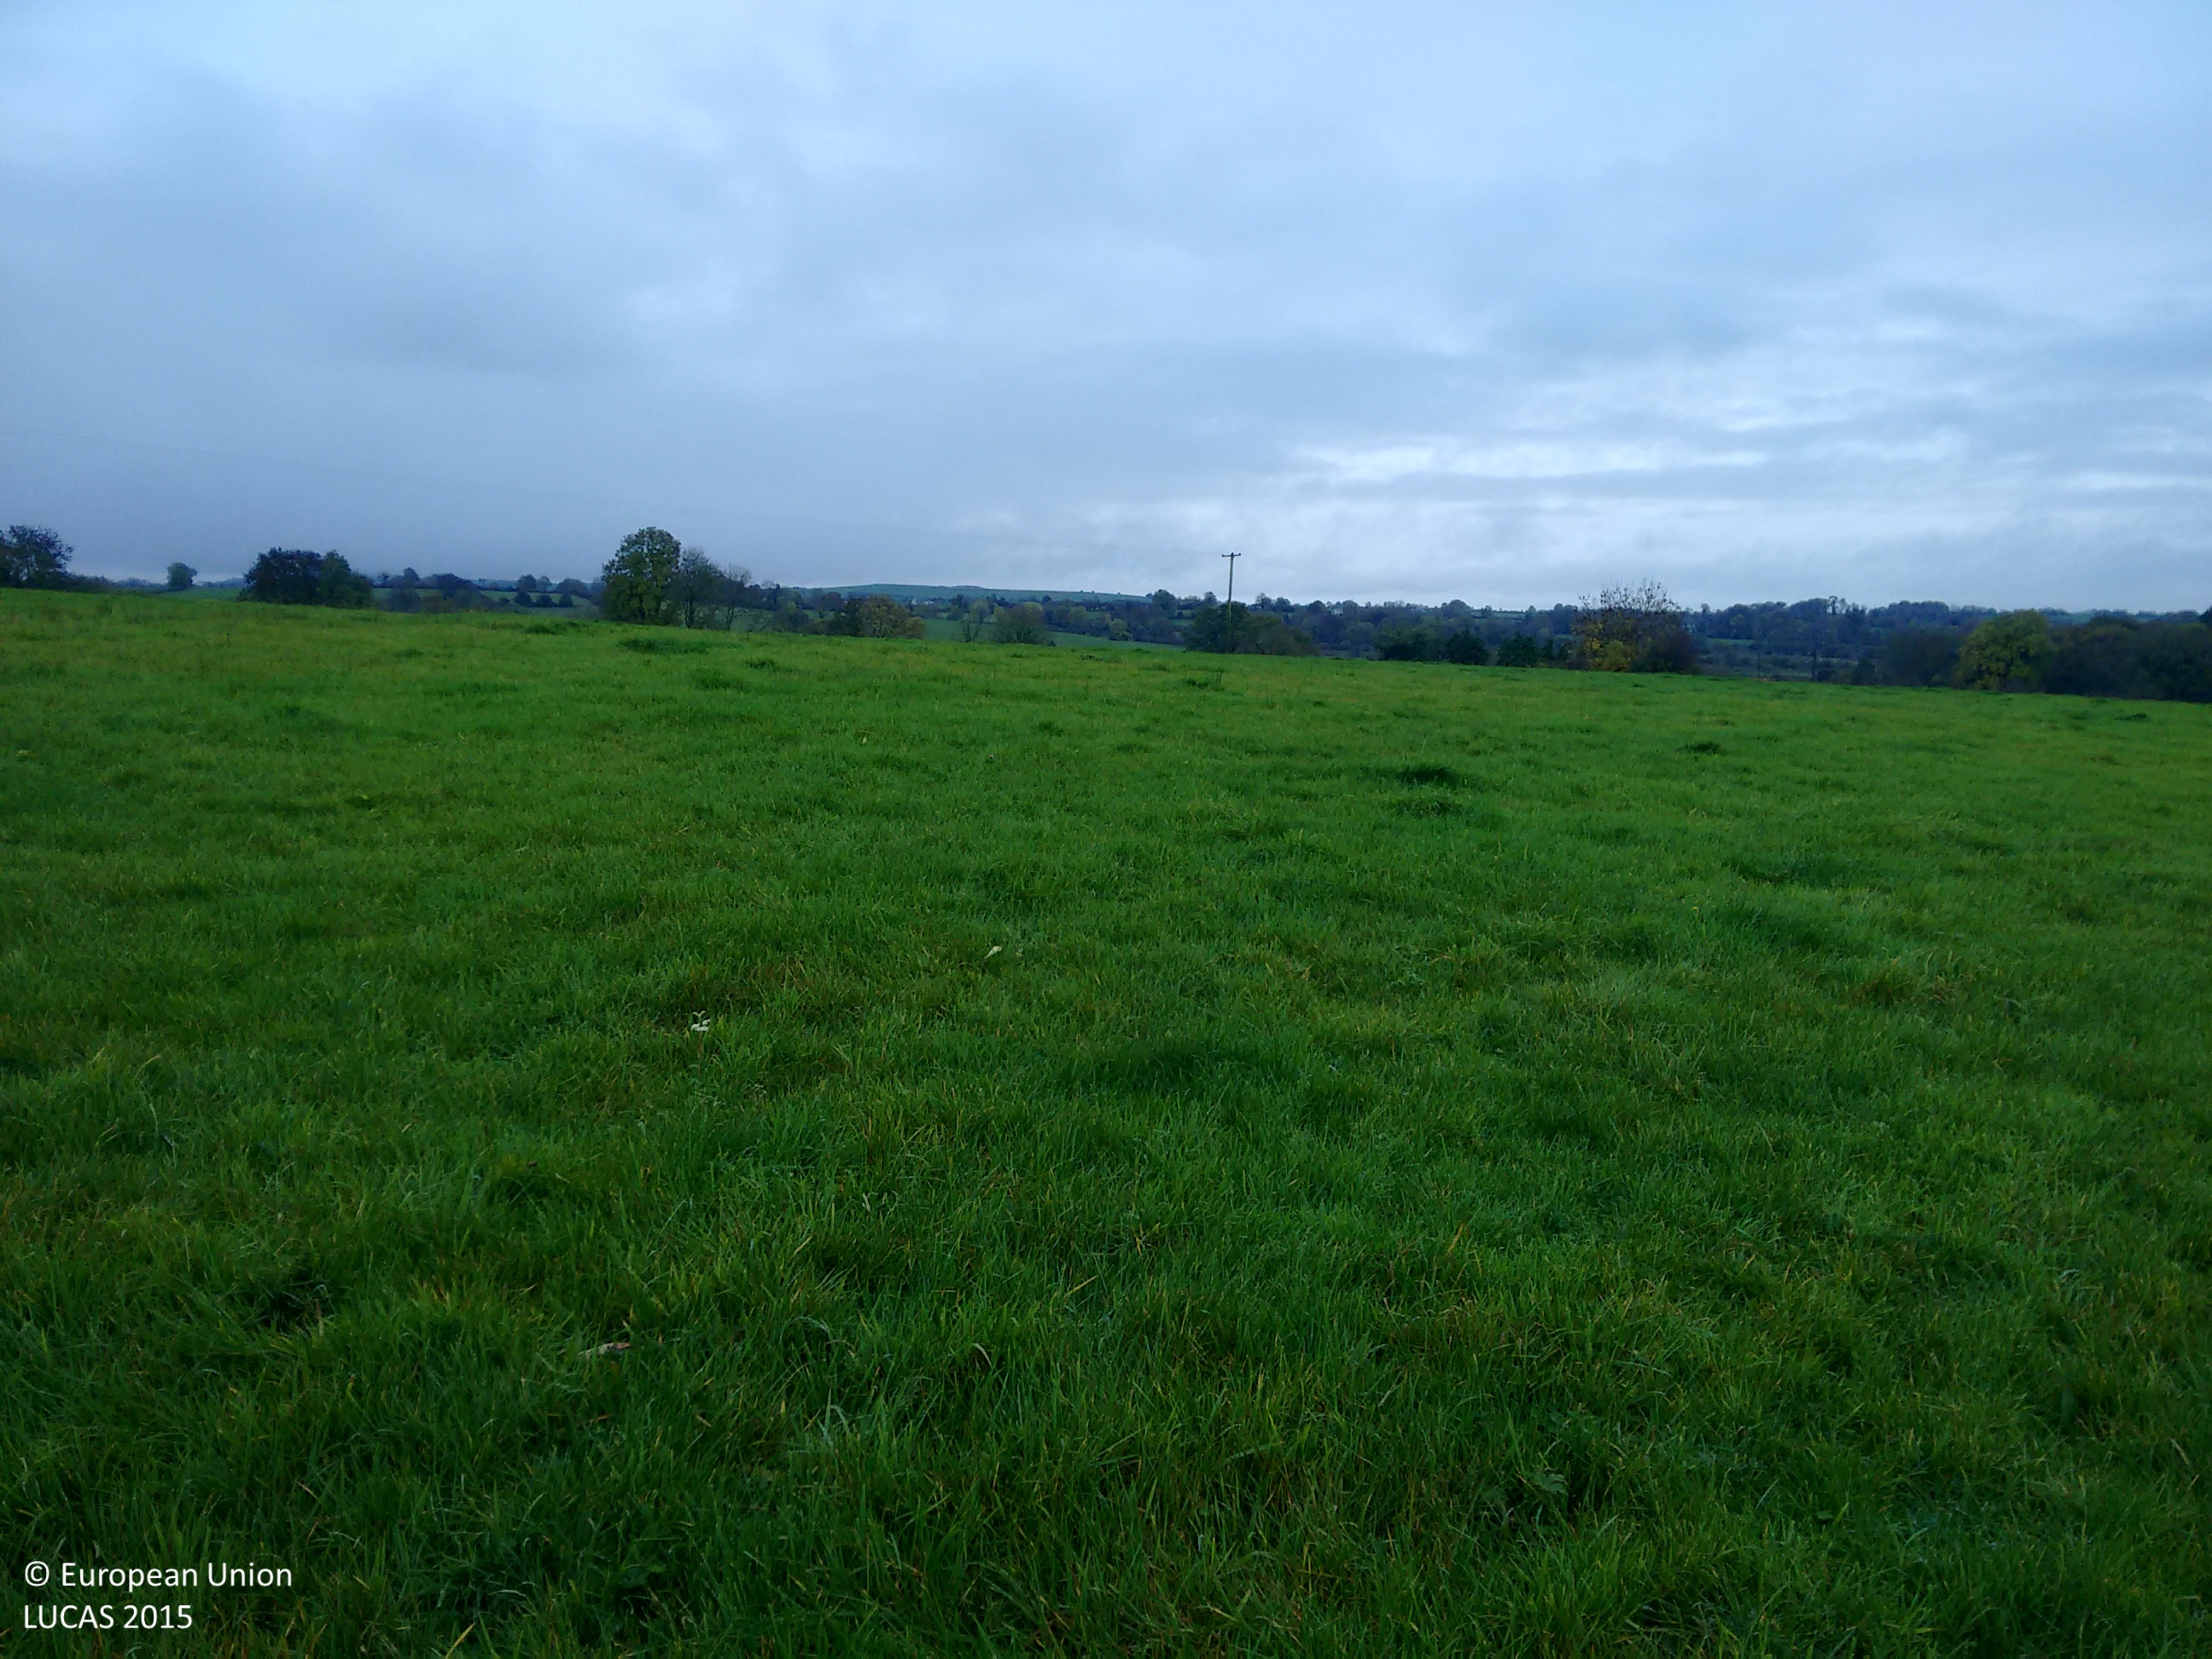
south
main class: Grassland
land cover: Grassland without tree/shrub cover
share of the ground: > 75 %
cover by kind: herbaceous plants 100 %
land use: Agriculture (excluding fallow land and kitchen gardens)
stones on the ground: < 10 %
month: October
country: IE
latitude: 53.8615
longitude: -8.1367
